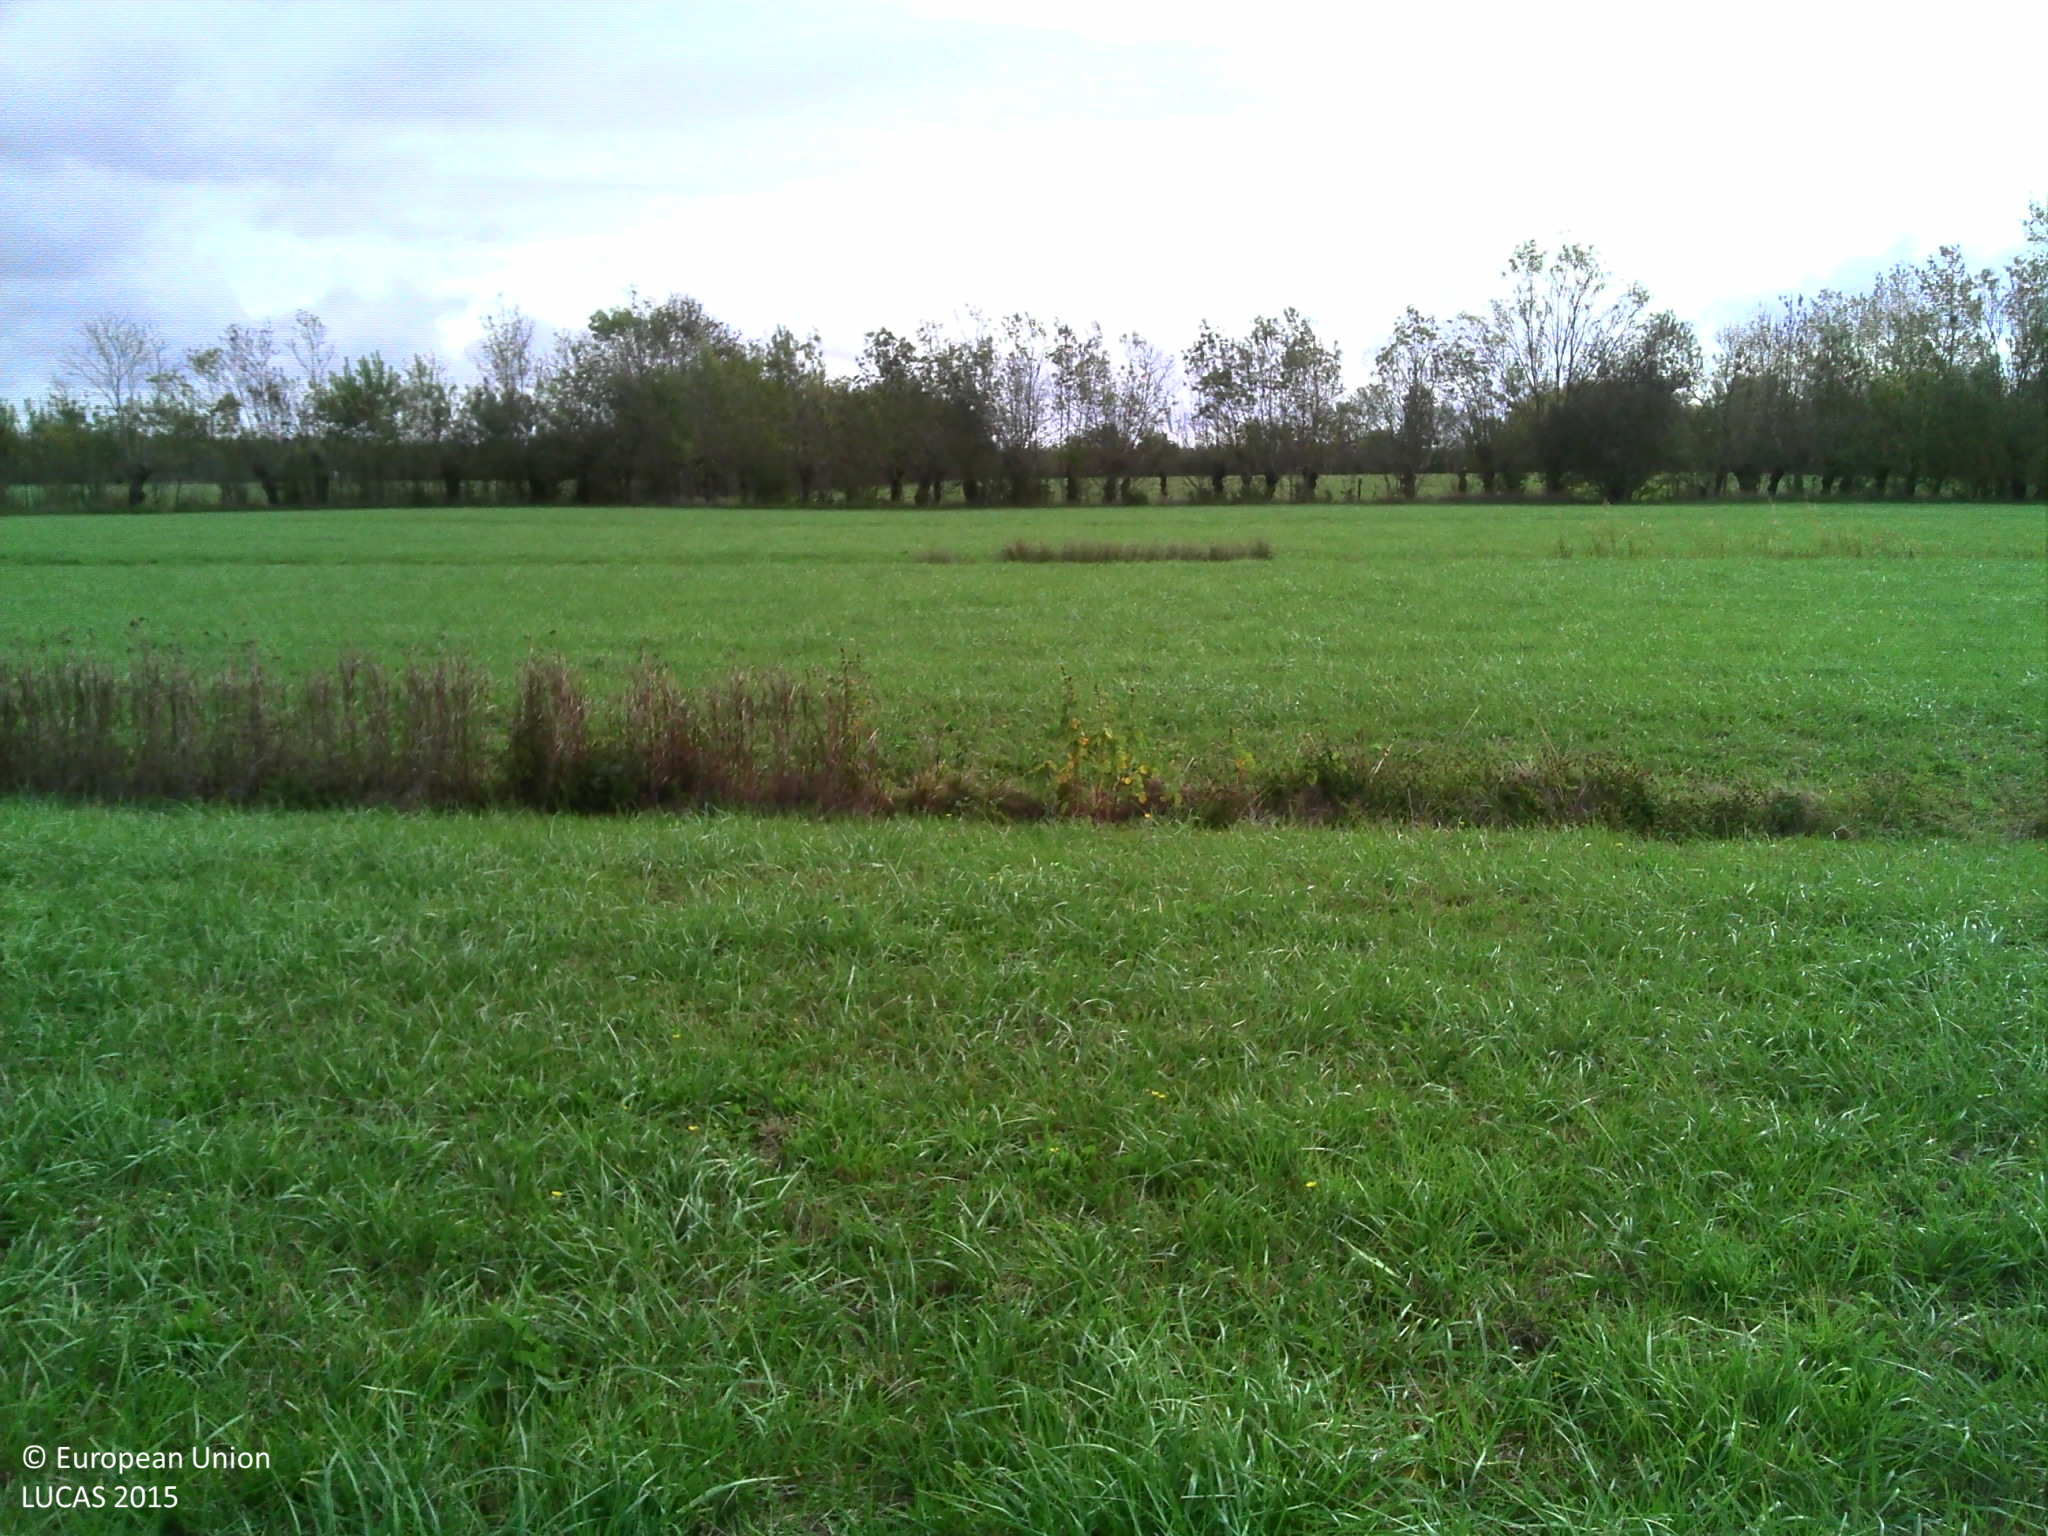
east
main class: Grassland
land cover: Grassland without tree/shrub cover
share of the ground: > 75 %
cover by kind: herbaceous plants 100 %
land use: Agriculture (excluding fallow land and kitchen gardens)
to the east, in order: Grassland without tree/shrub cover; Ditches and canals; Grassland without tree/shrub cover; Ditches and canals; Grassland without tree/shrub cover; Ditches and canals; Grassland without tree/shrub cover; Fences; Lines of trees; Rivers and streams; Lines of trees; Fences; Grassland without tree/shrub cover; Lines of trees; Ditches and canals; Grassland without tree/shrub cover
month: October
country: FR
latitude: 46.4483
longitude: -1.0585
